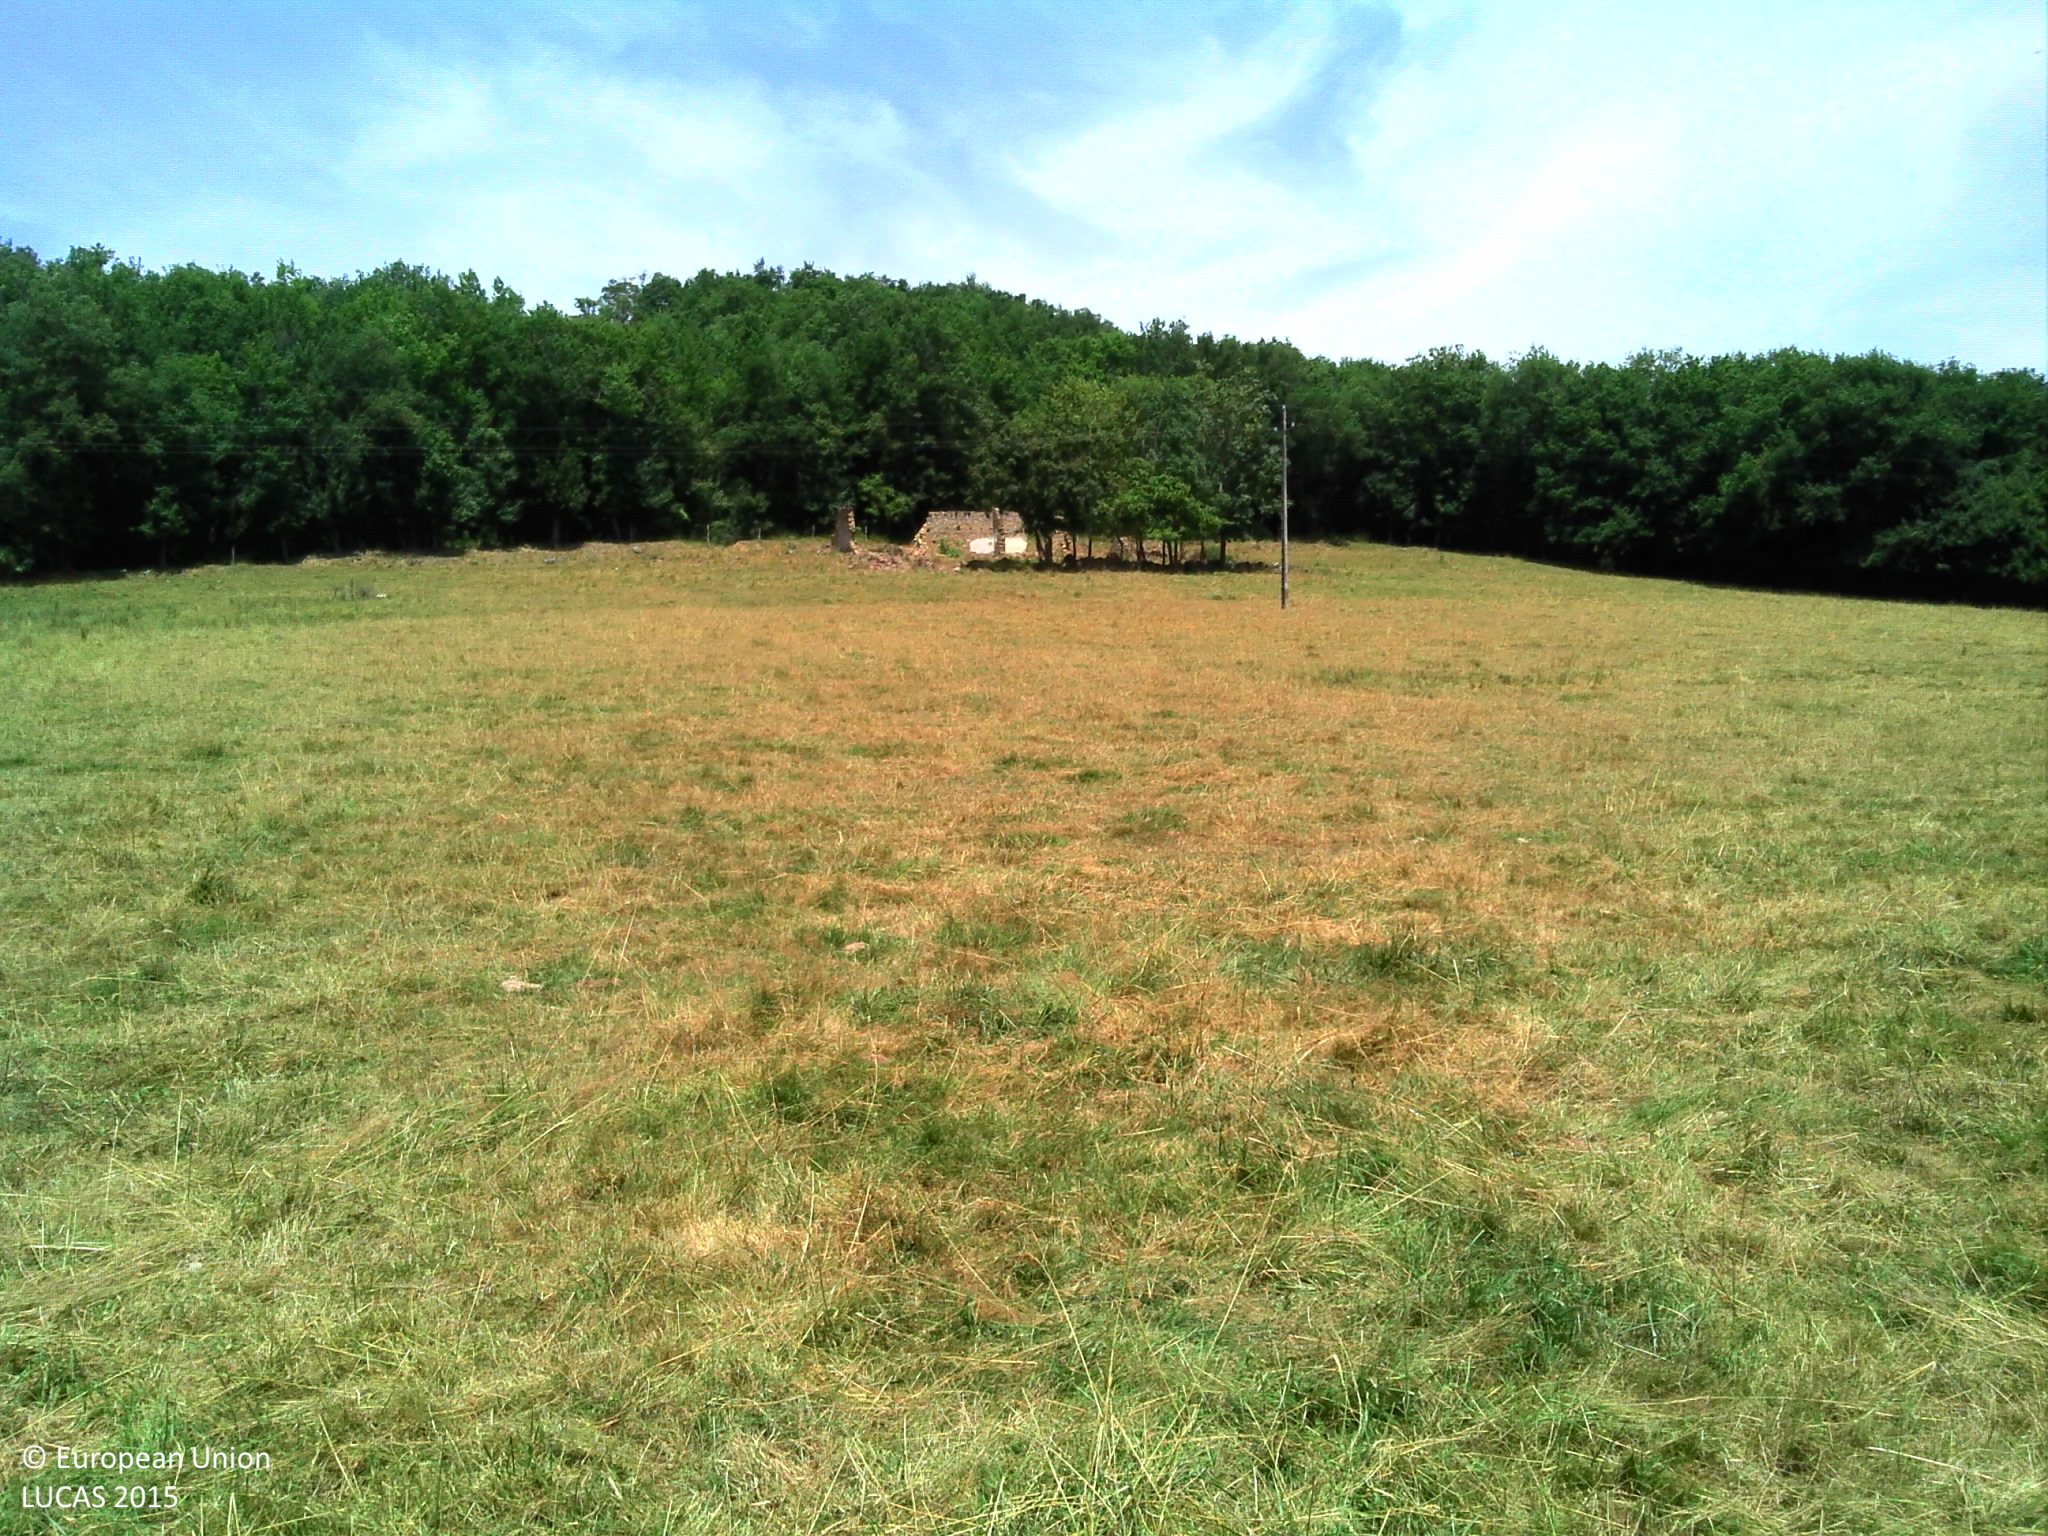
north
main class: Grassland
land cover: Grassland without tree/shrub cover
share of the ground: > 75 %
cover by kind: herbaceous plants 100 %
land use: Agriculture (excluding fallow land and kitchen gardens)
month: July
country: FR
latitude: 43.0860
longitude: 0.7771
